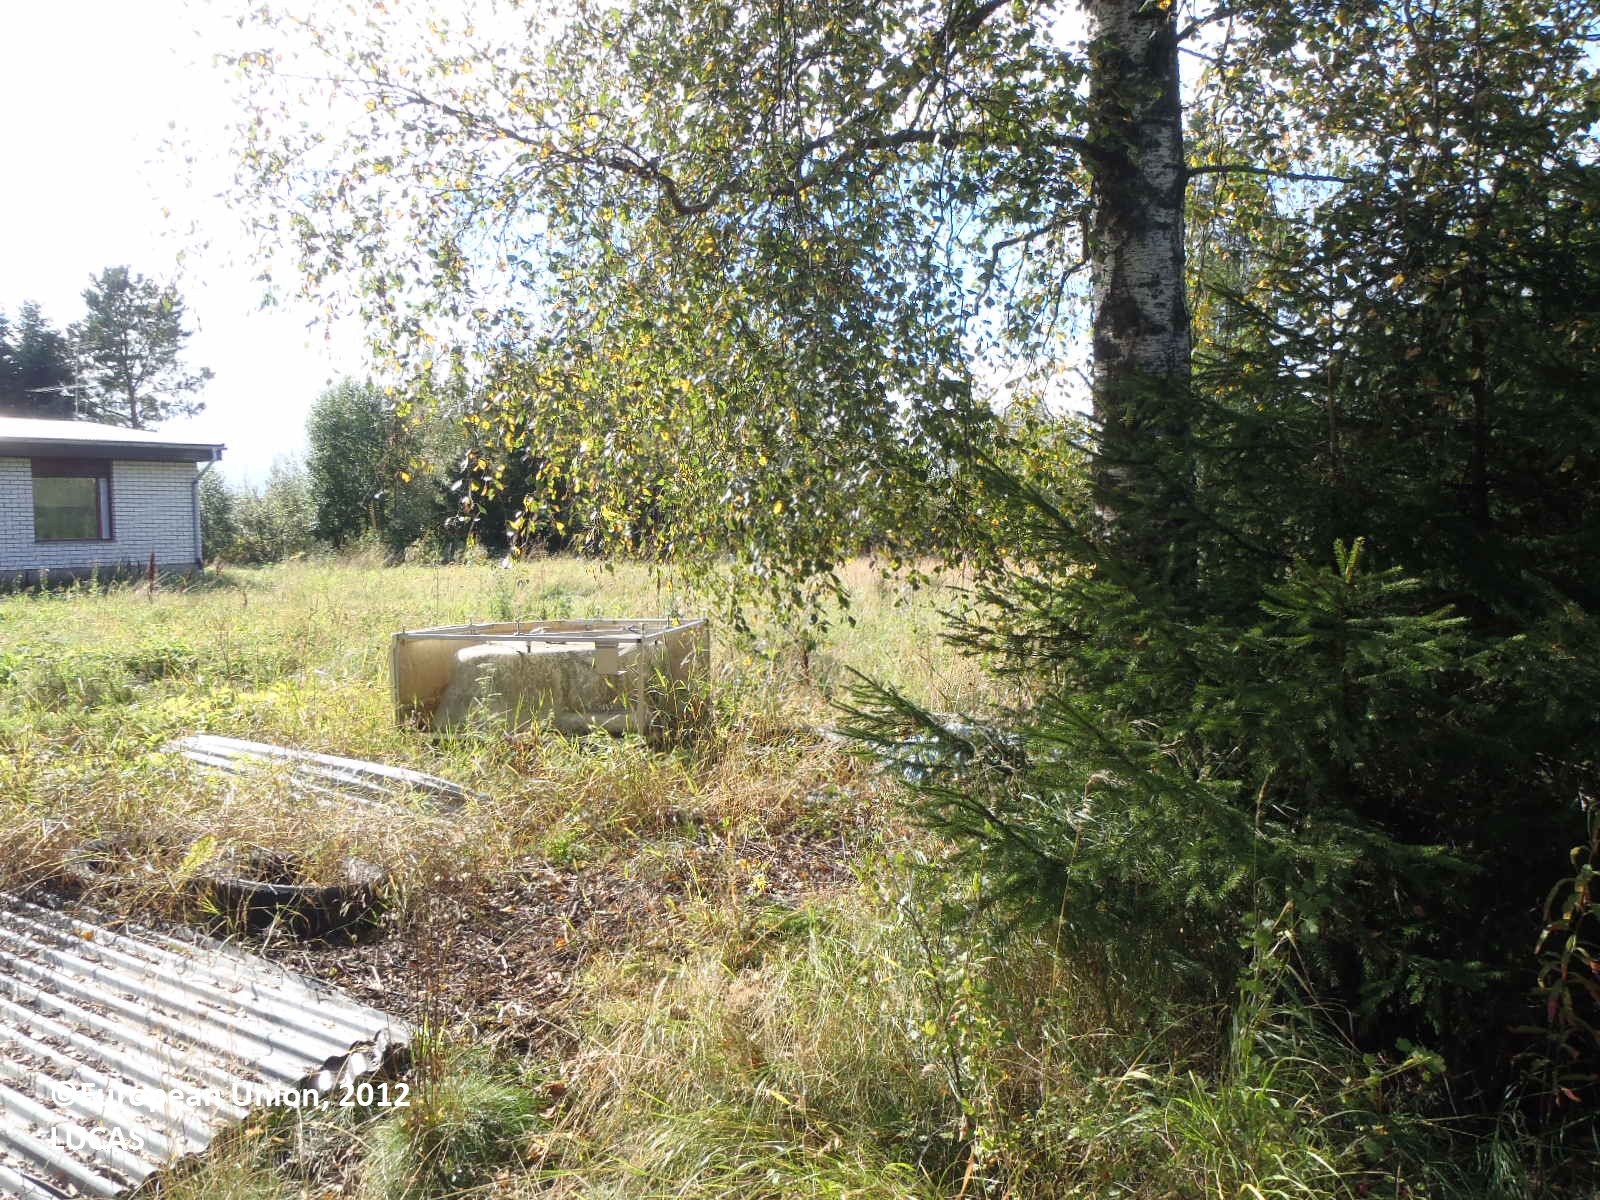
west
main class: Woodland
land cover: Spruce dominated mixed woodland
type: boreal forest
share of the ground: > 75 %
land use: Forestry
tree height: > 5 m
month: September
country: FI
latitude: 60.8917
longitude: 22.8062
